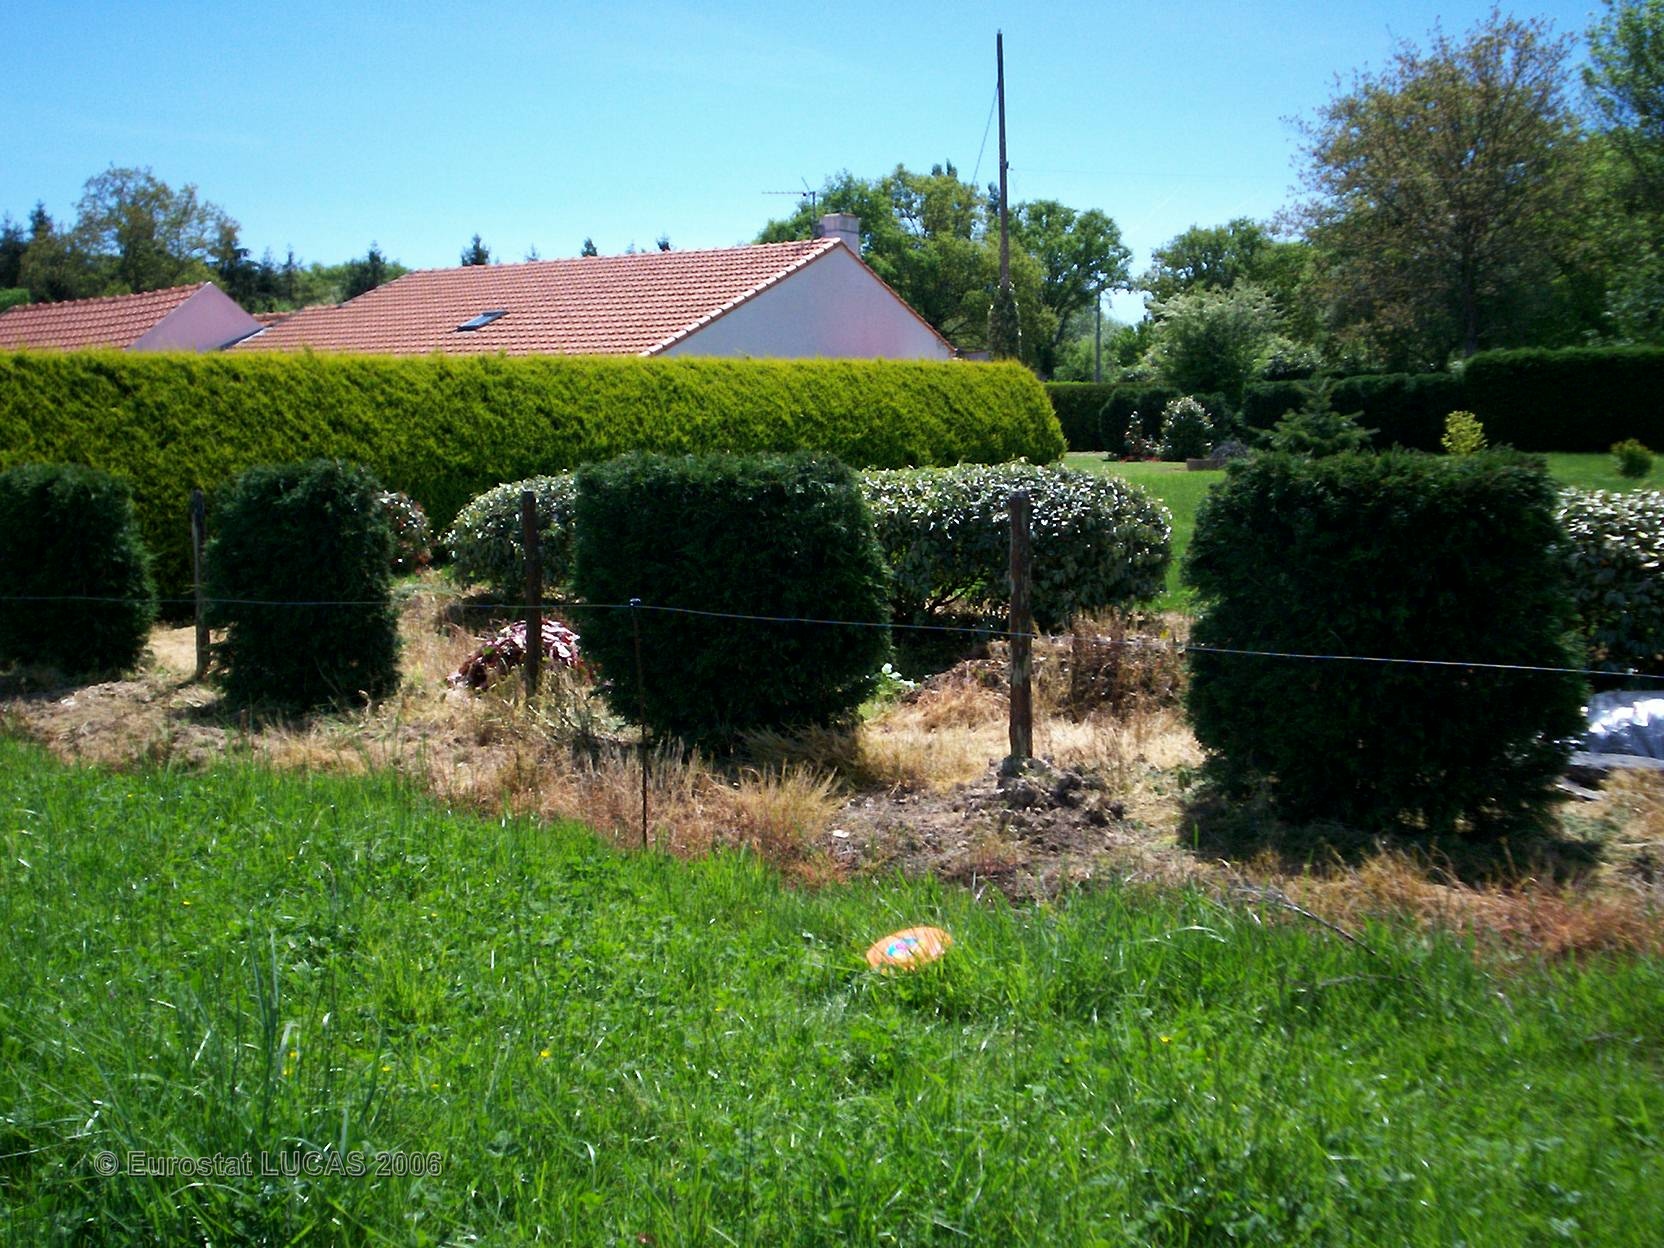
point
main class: Grassland
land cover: Grassland without tree/shrub cover
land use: Agriculture (excluding fallow land and kitchen gardens)
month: May
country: FR
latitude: 47.1372
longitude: -2.0867
